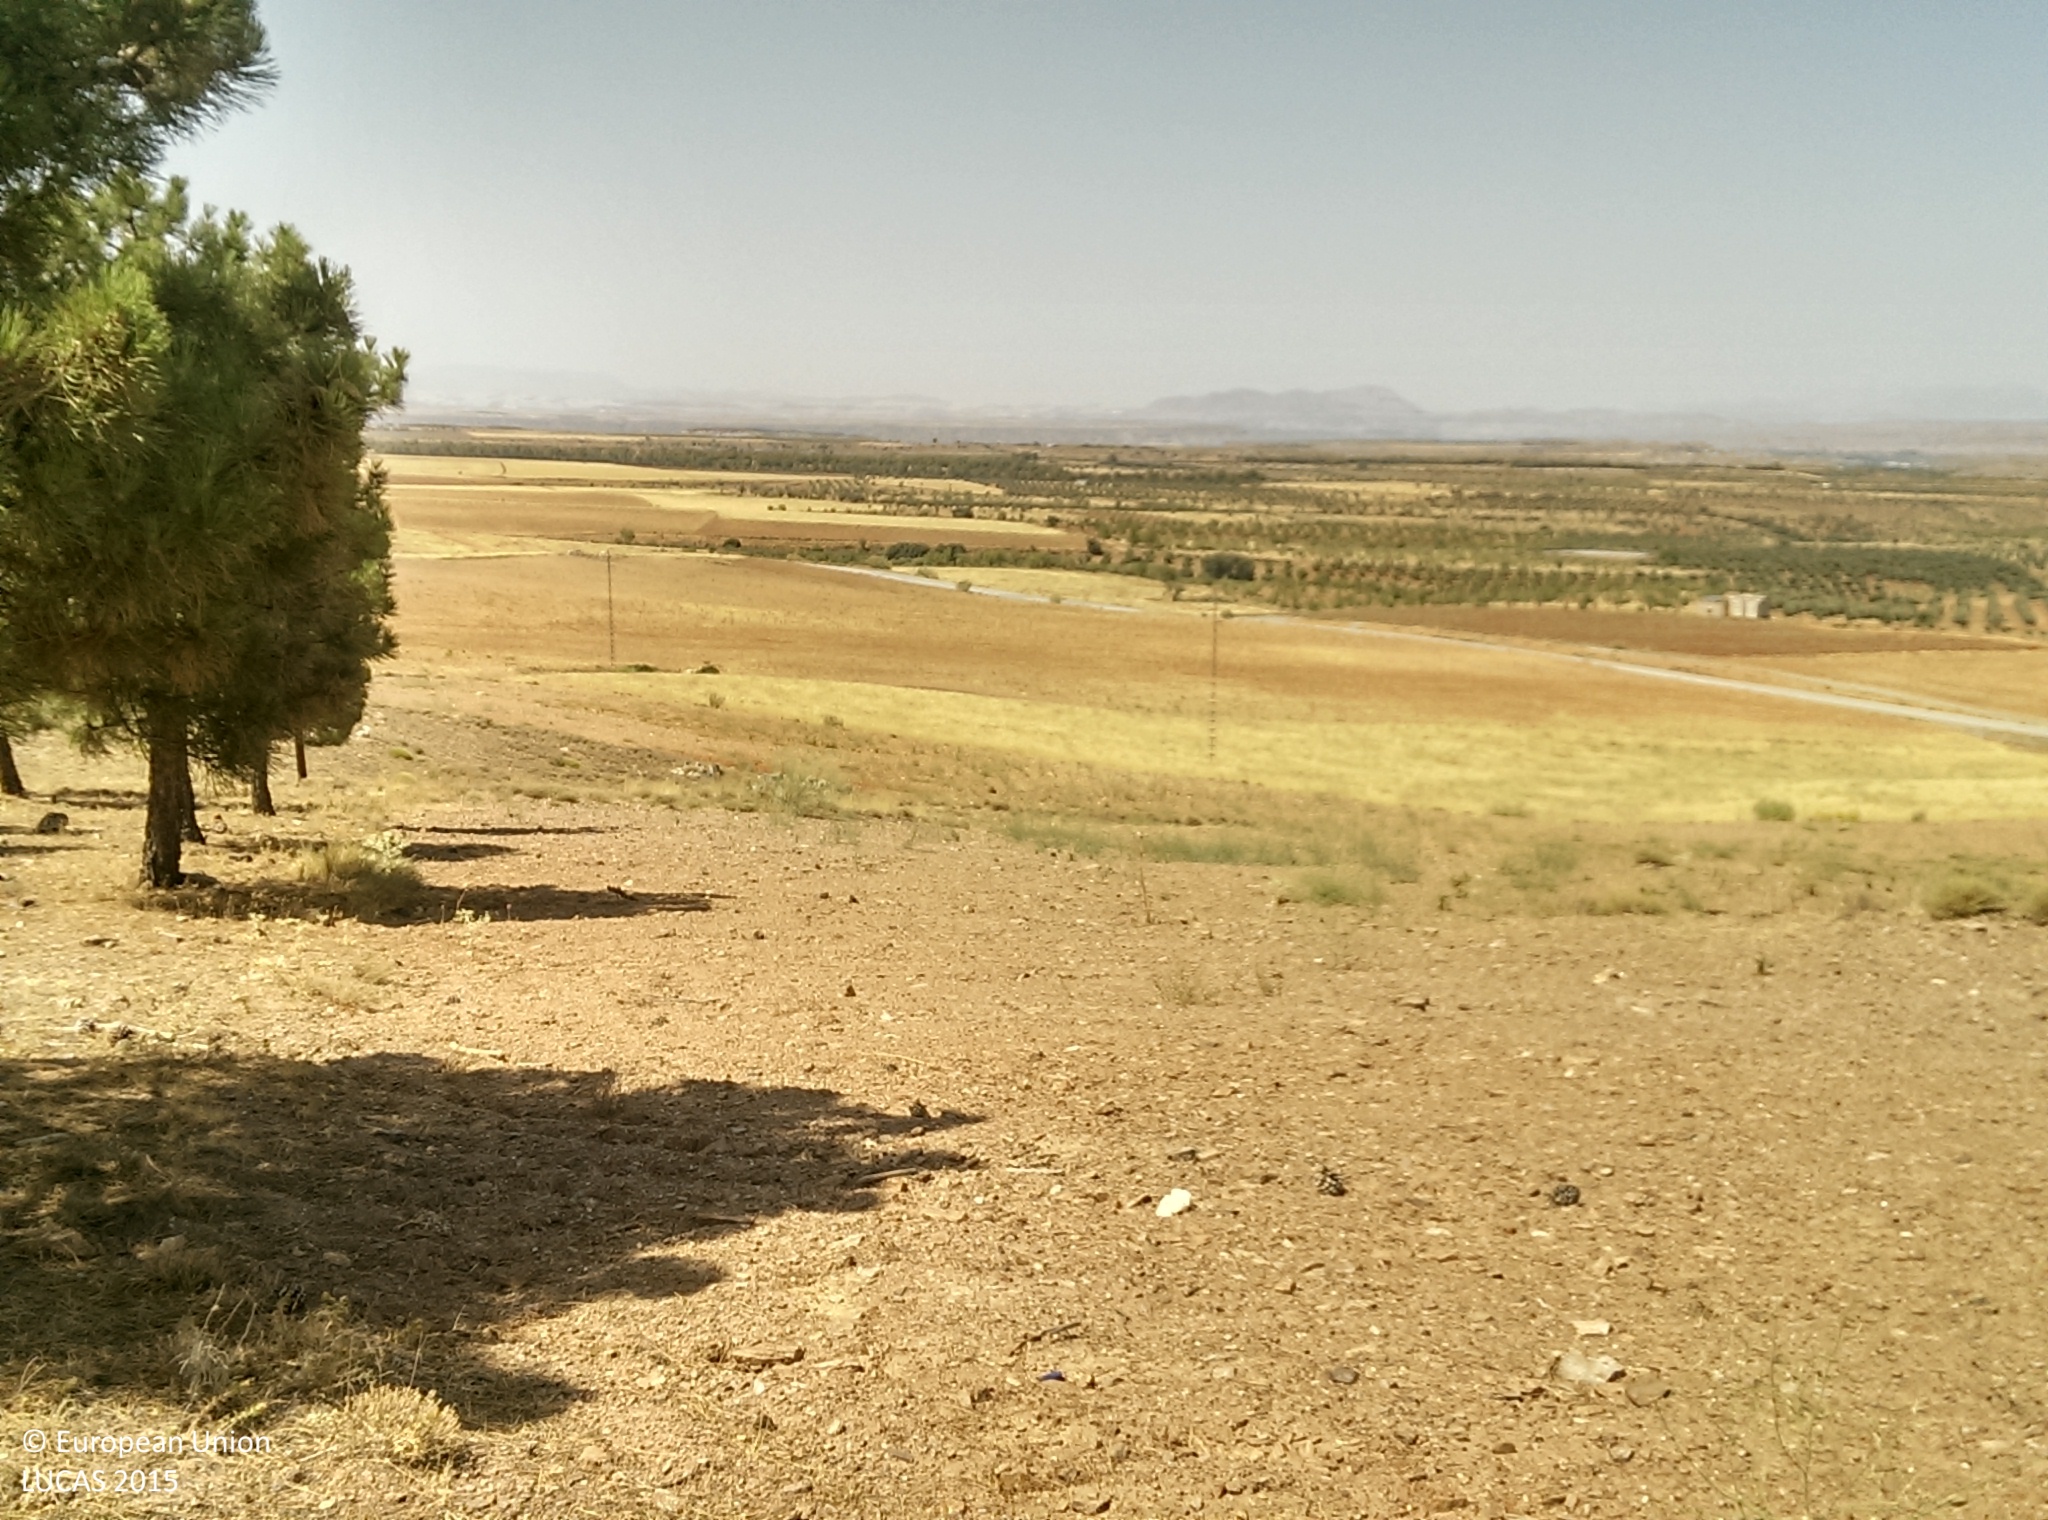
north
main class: Woodland
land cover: Pine dominated coniferous woodland
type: coniferous forest of the mediterranean region
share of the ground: 10 - 25 %
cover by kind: herbaceous plants 40 %, coniferous forest trees 20 %, shrubs 20 %, unconsolidated bare surface 20 %
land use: Forestry
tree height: > 5 m
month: July
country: ES
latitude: 37.2289
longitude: -3.1846
